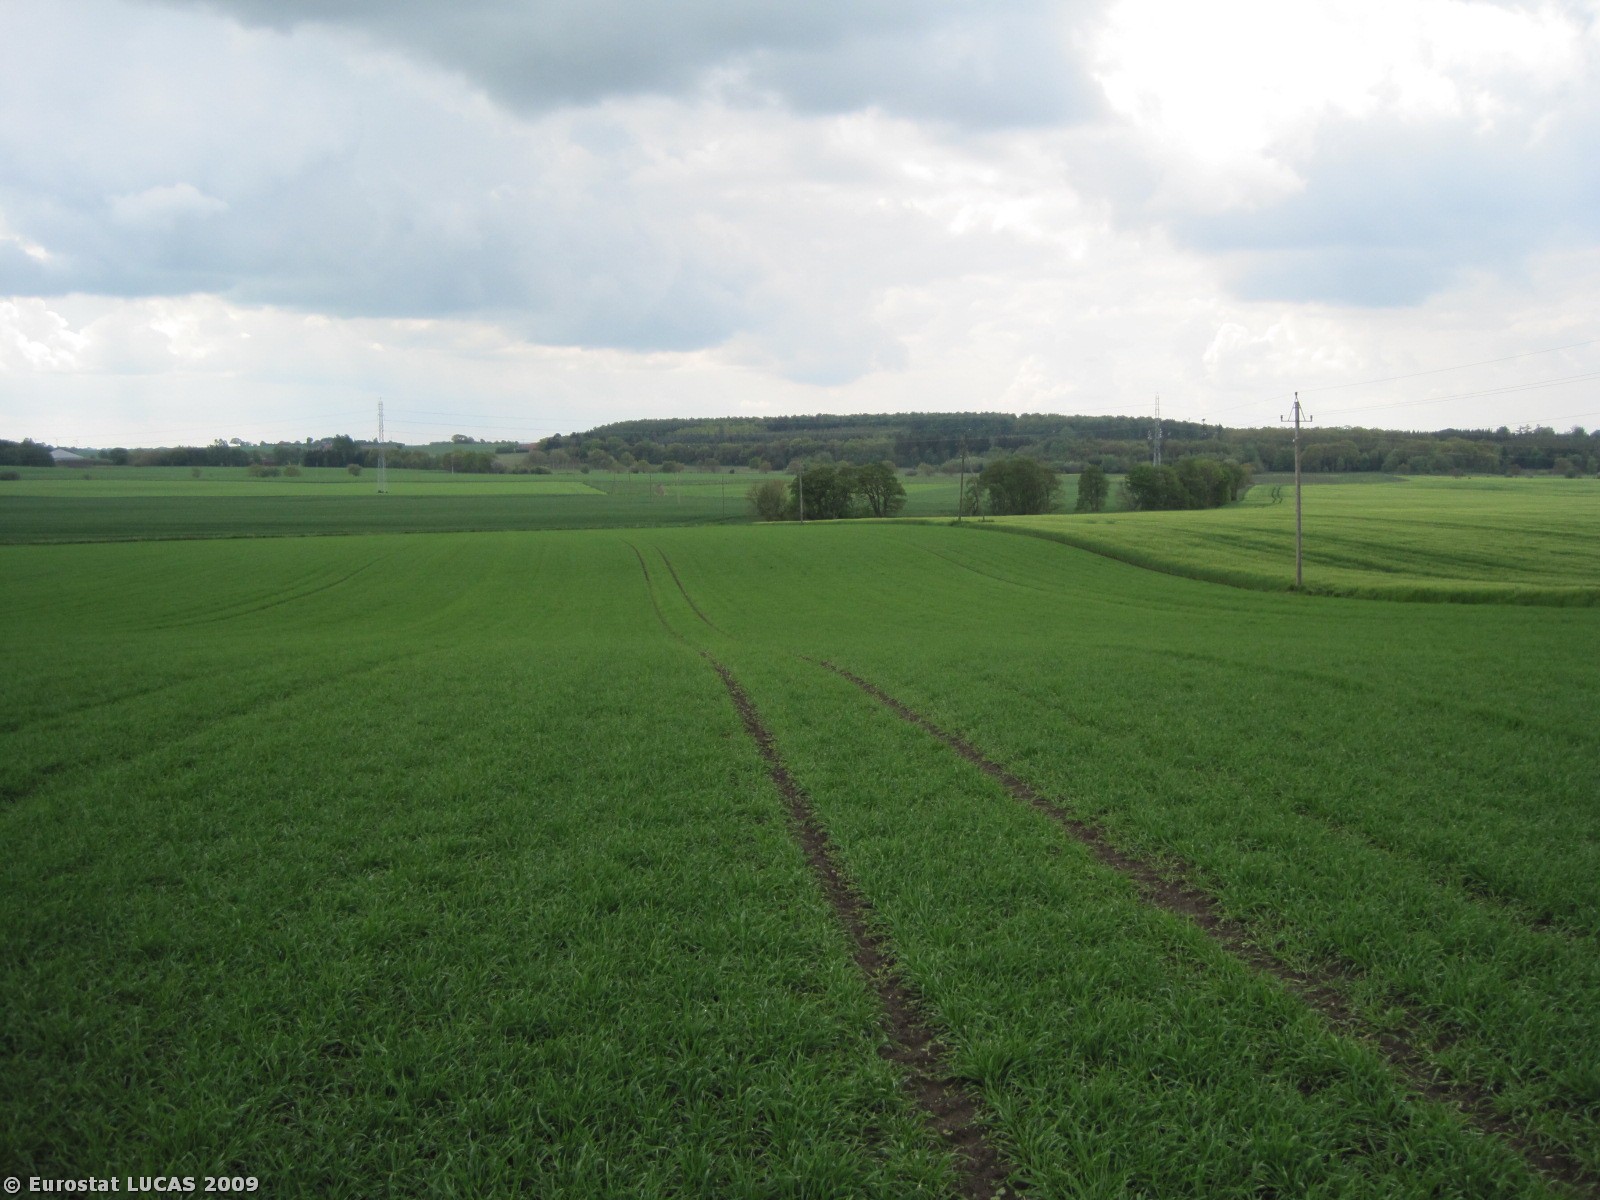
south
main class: Cropland
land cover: Barley
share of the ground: > 75 %
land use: Agriculture (excluding fallow land and kitchen gardens)
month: May
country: DK
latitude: 56.3493
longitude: 9.7576
